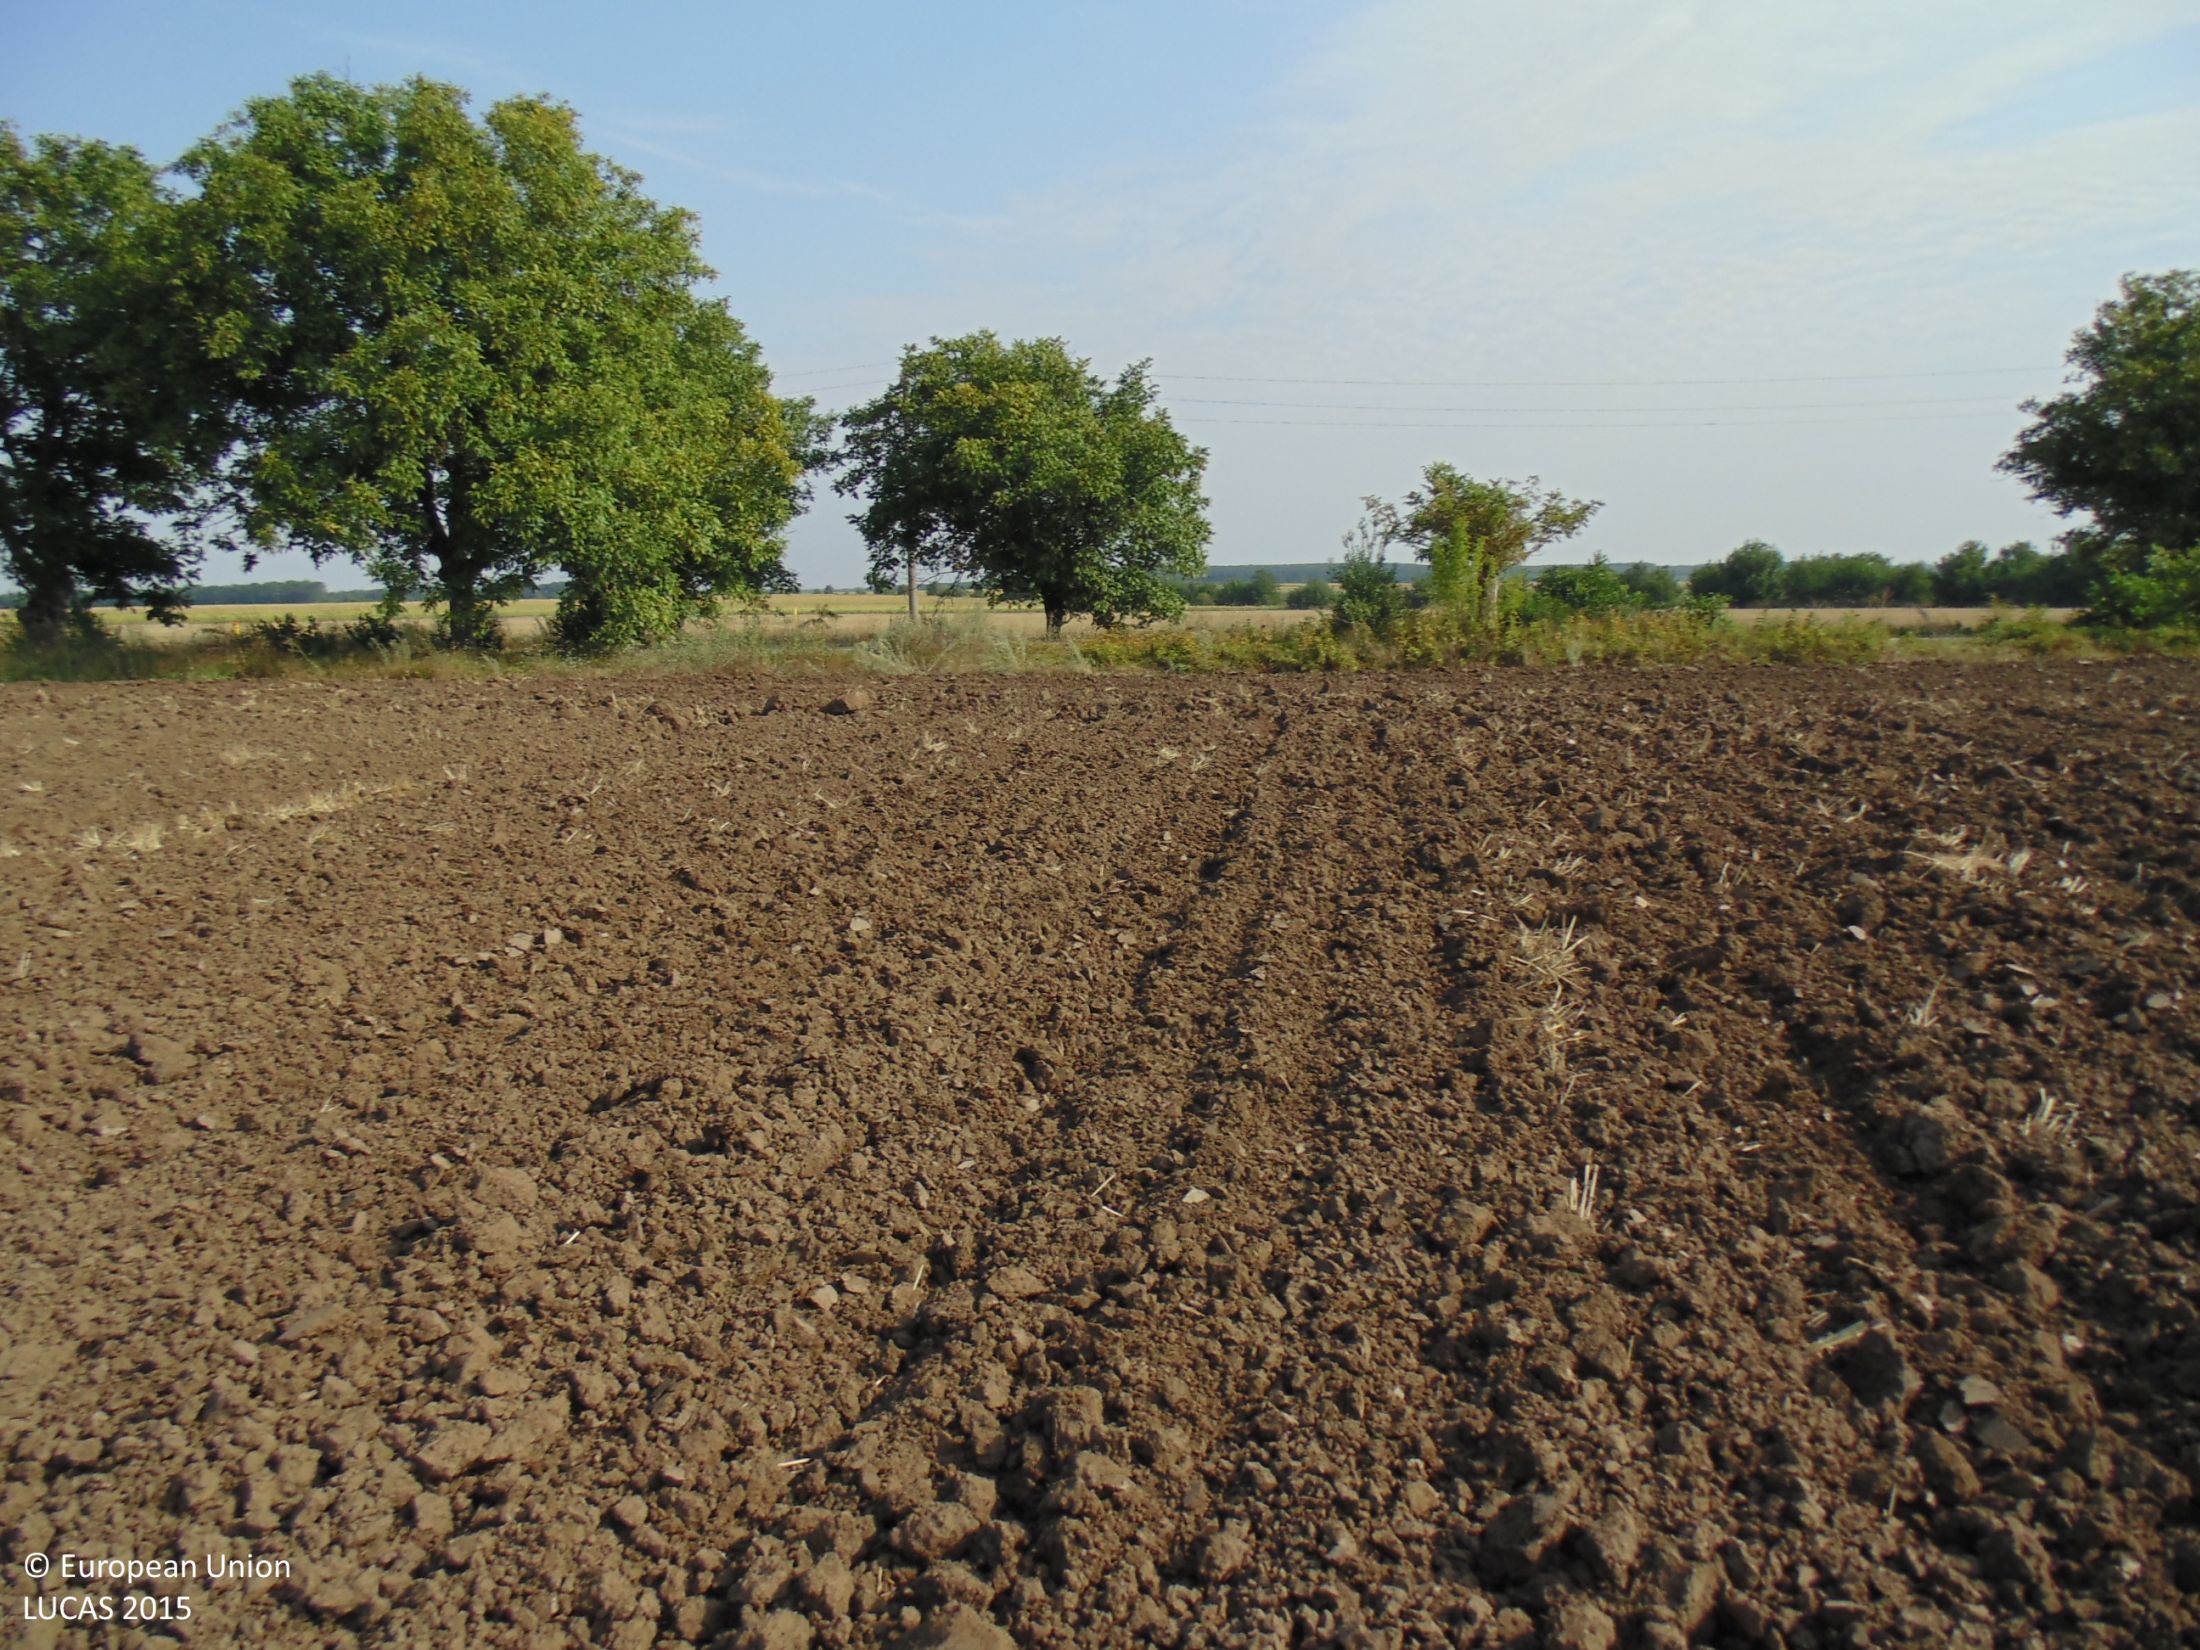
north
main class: Cropland
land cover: Common wheat
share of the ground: < 10 %
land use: Agriculture (excluding fallow land and kitchen gardens)
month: August
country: BG
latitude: 43.7168
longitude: 27.7025
